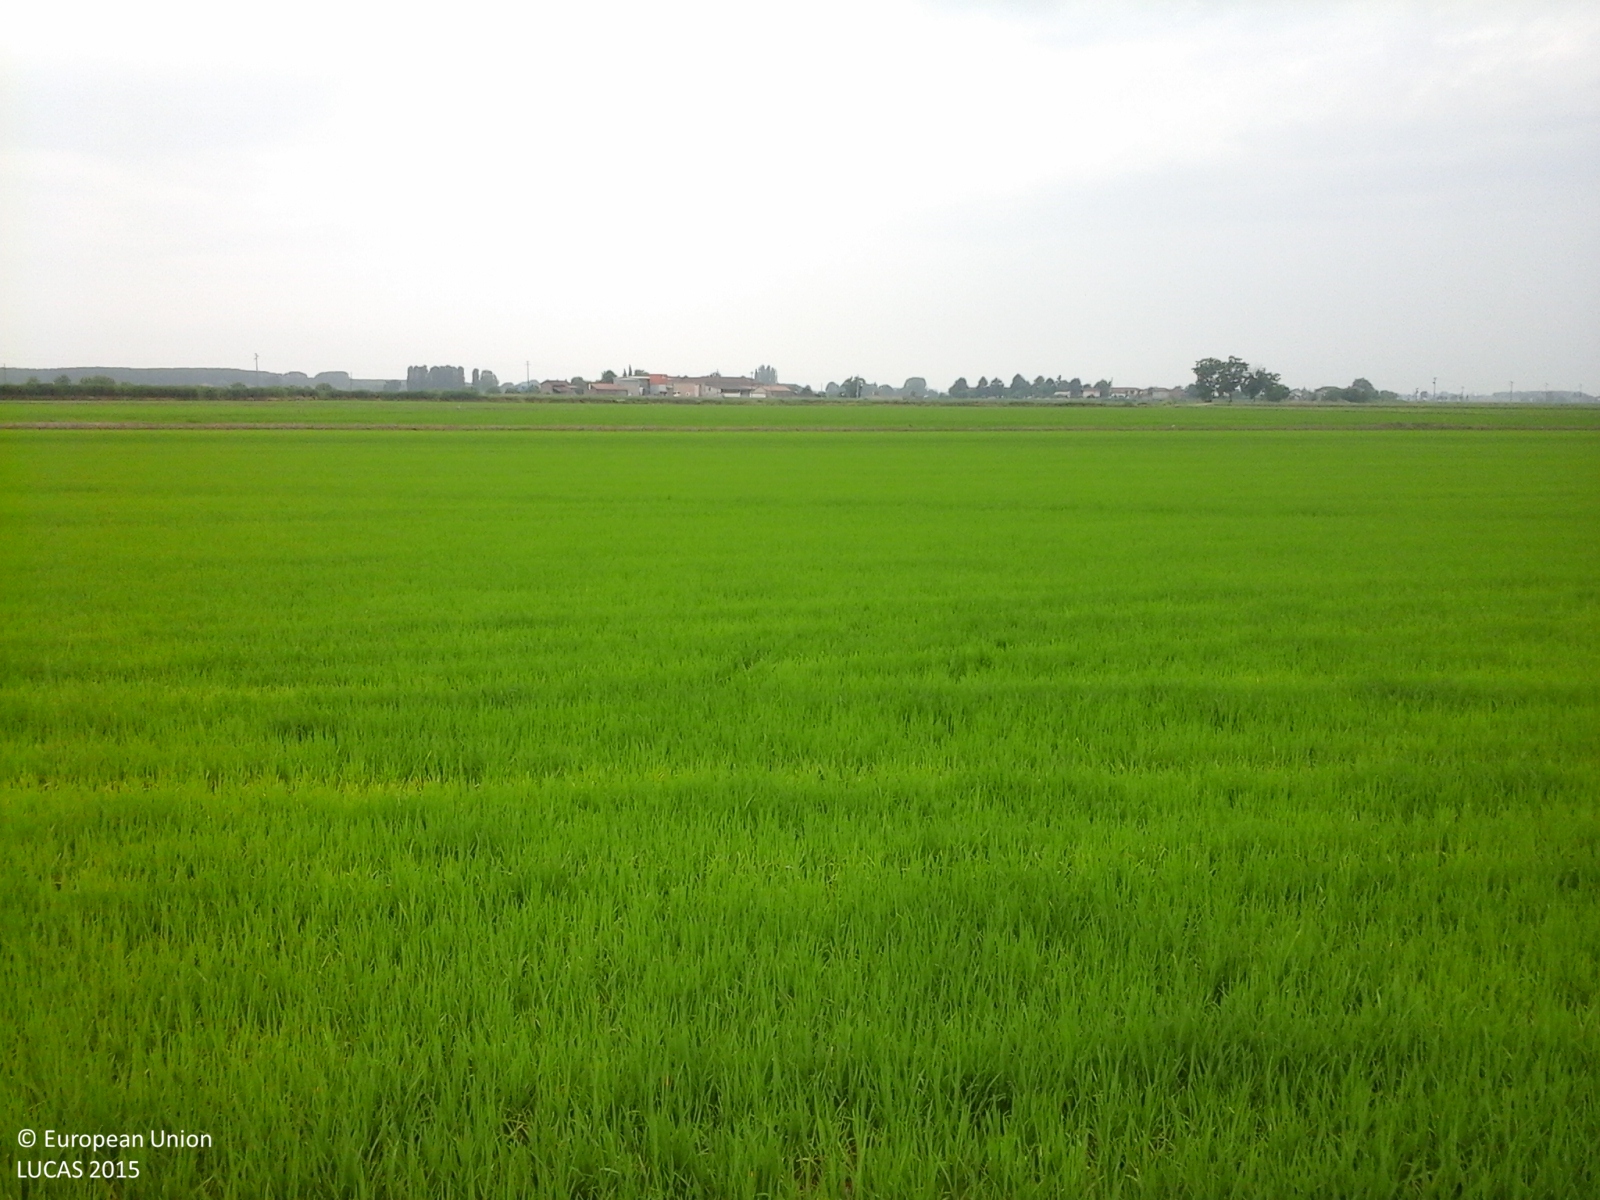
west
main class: Cropland
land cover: Rice
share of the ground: > 75 %
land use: Agriculture (excluding fallow land and kitchen gardens)
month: June
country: IT
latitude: 45.3136
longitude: 8.5102
